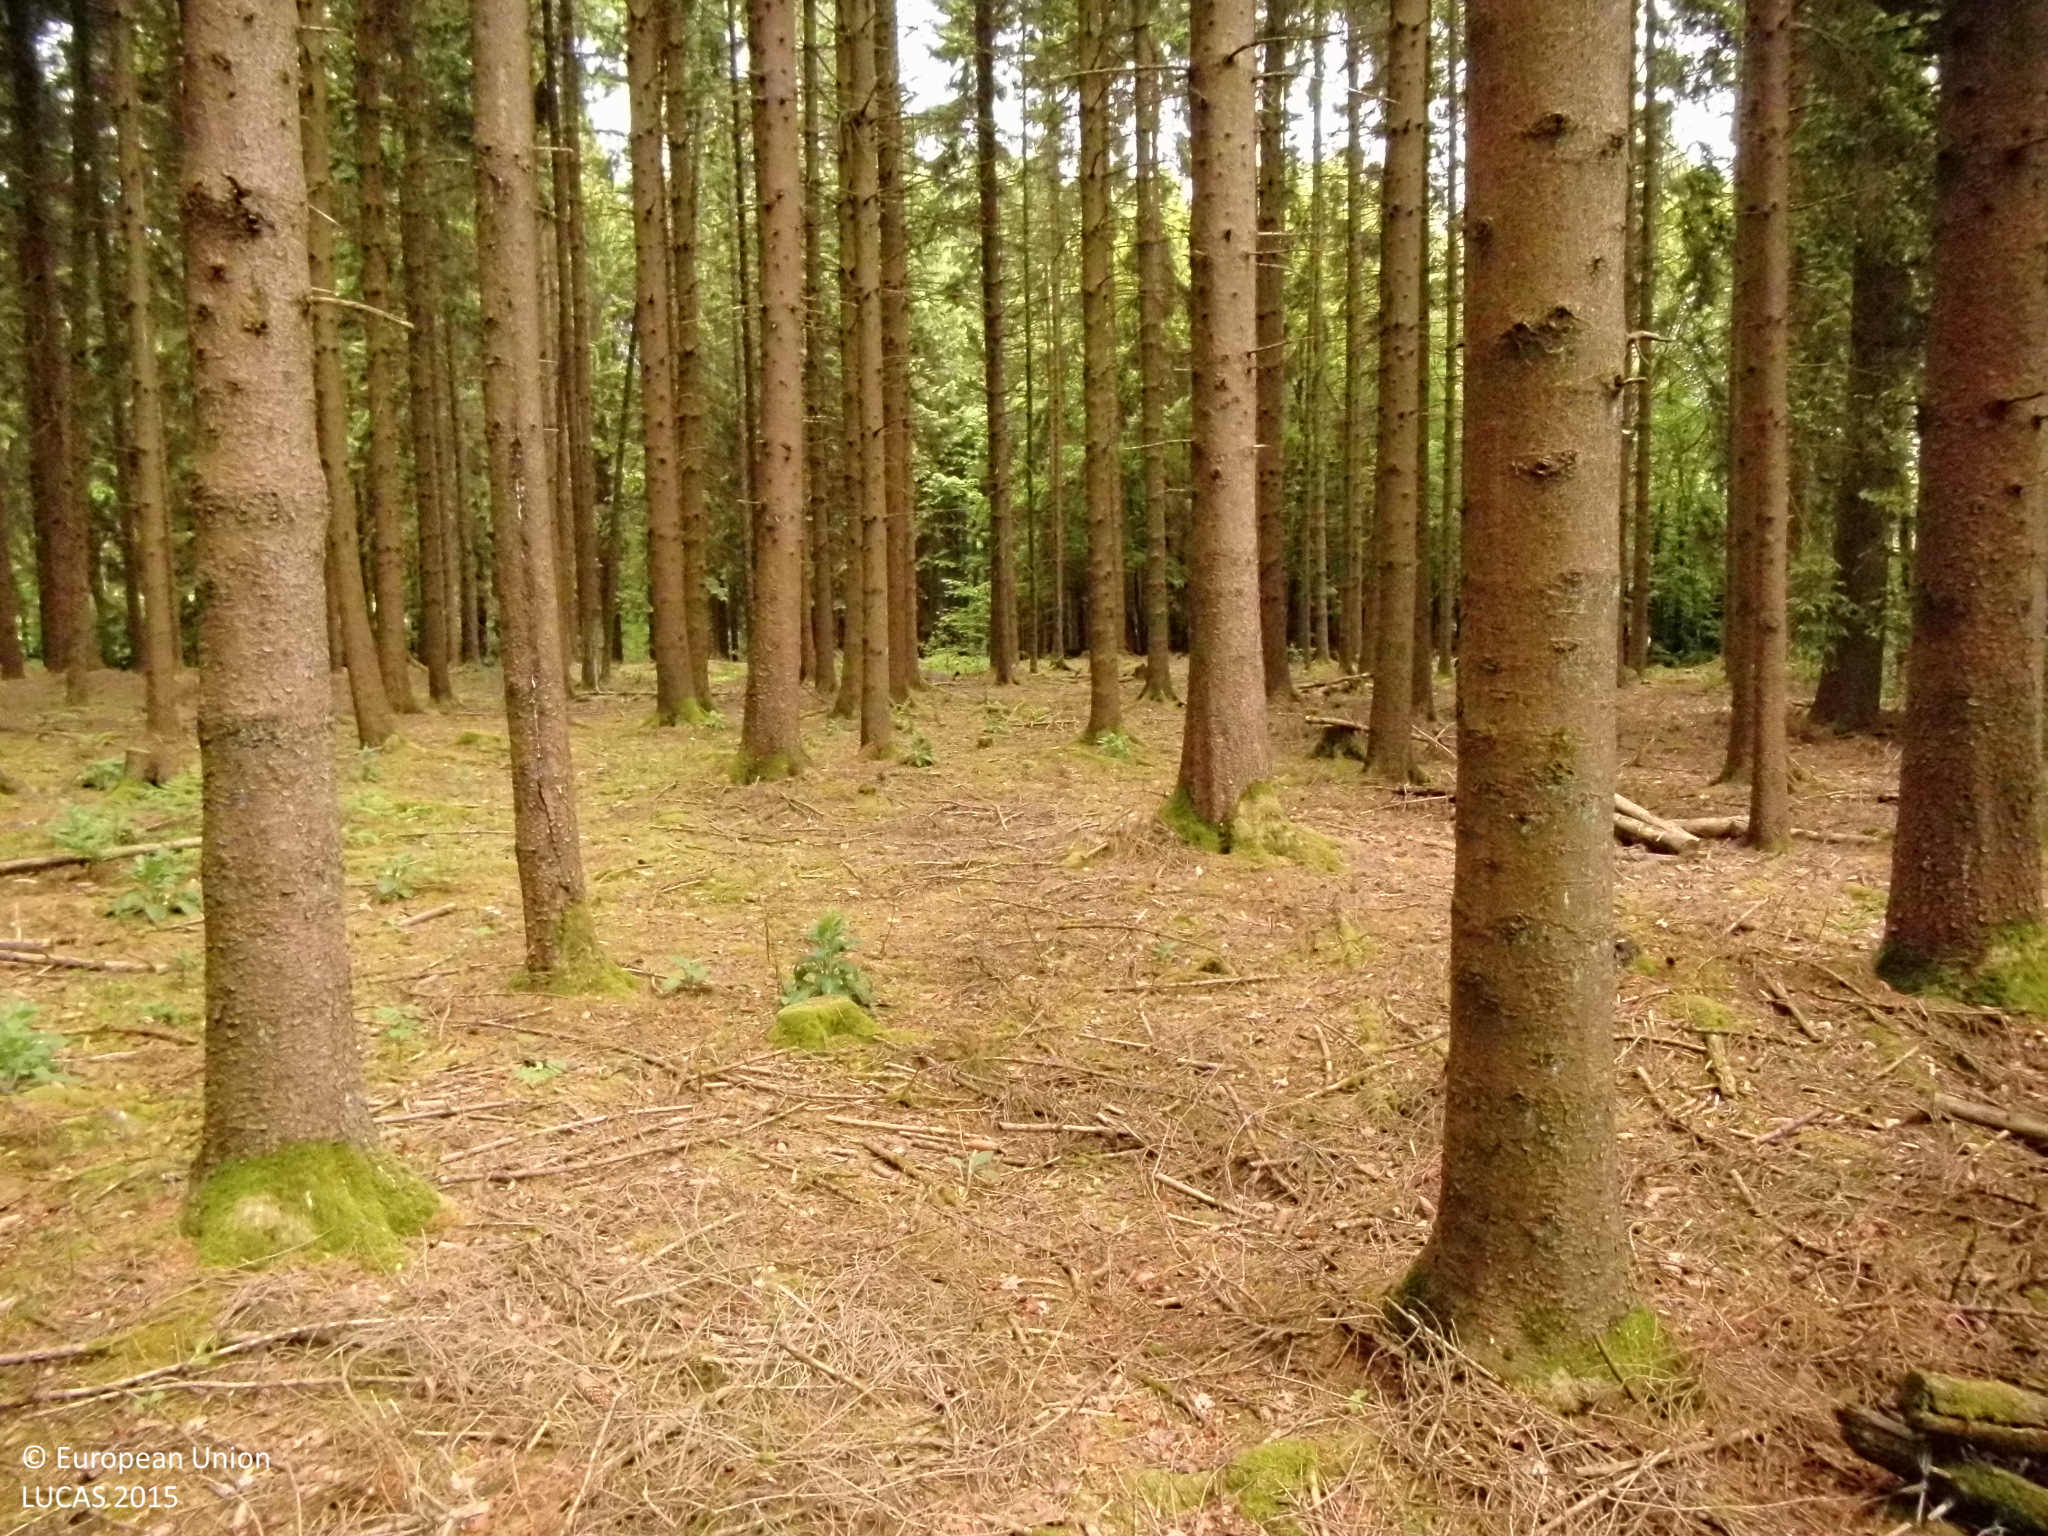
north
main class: Woodland
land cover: Spruce dominated coniferous woodland
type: hemiboreal forest and nemoral coniferous forest and mixed broadleaved-coniferous forest
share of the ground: > 75 %
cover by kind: coniferous forest trees 80 %, unconsolidated bare surface 15 %, herbaceous plants 5 %
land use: Forestry
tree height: > 5 m
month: May
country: DE
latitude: 50.9306
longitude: 7.5103
